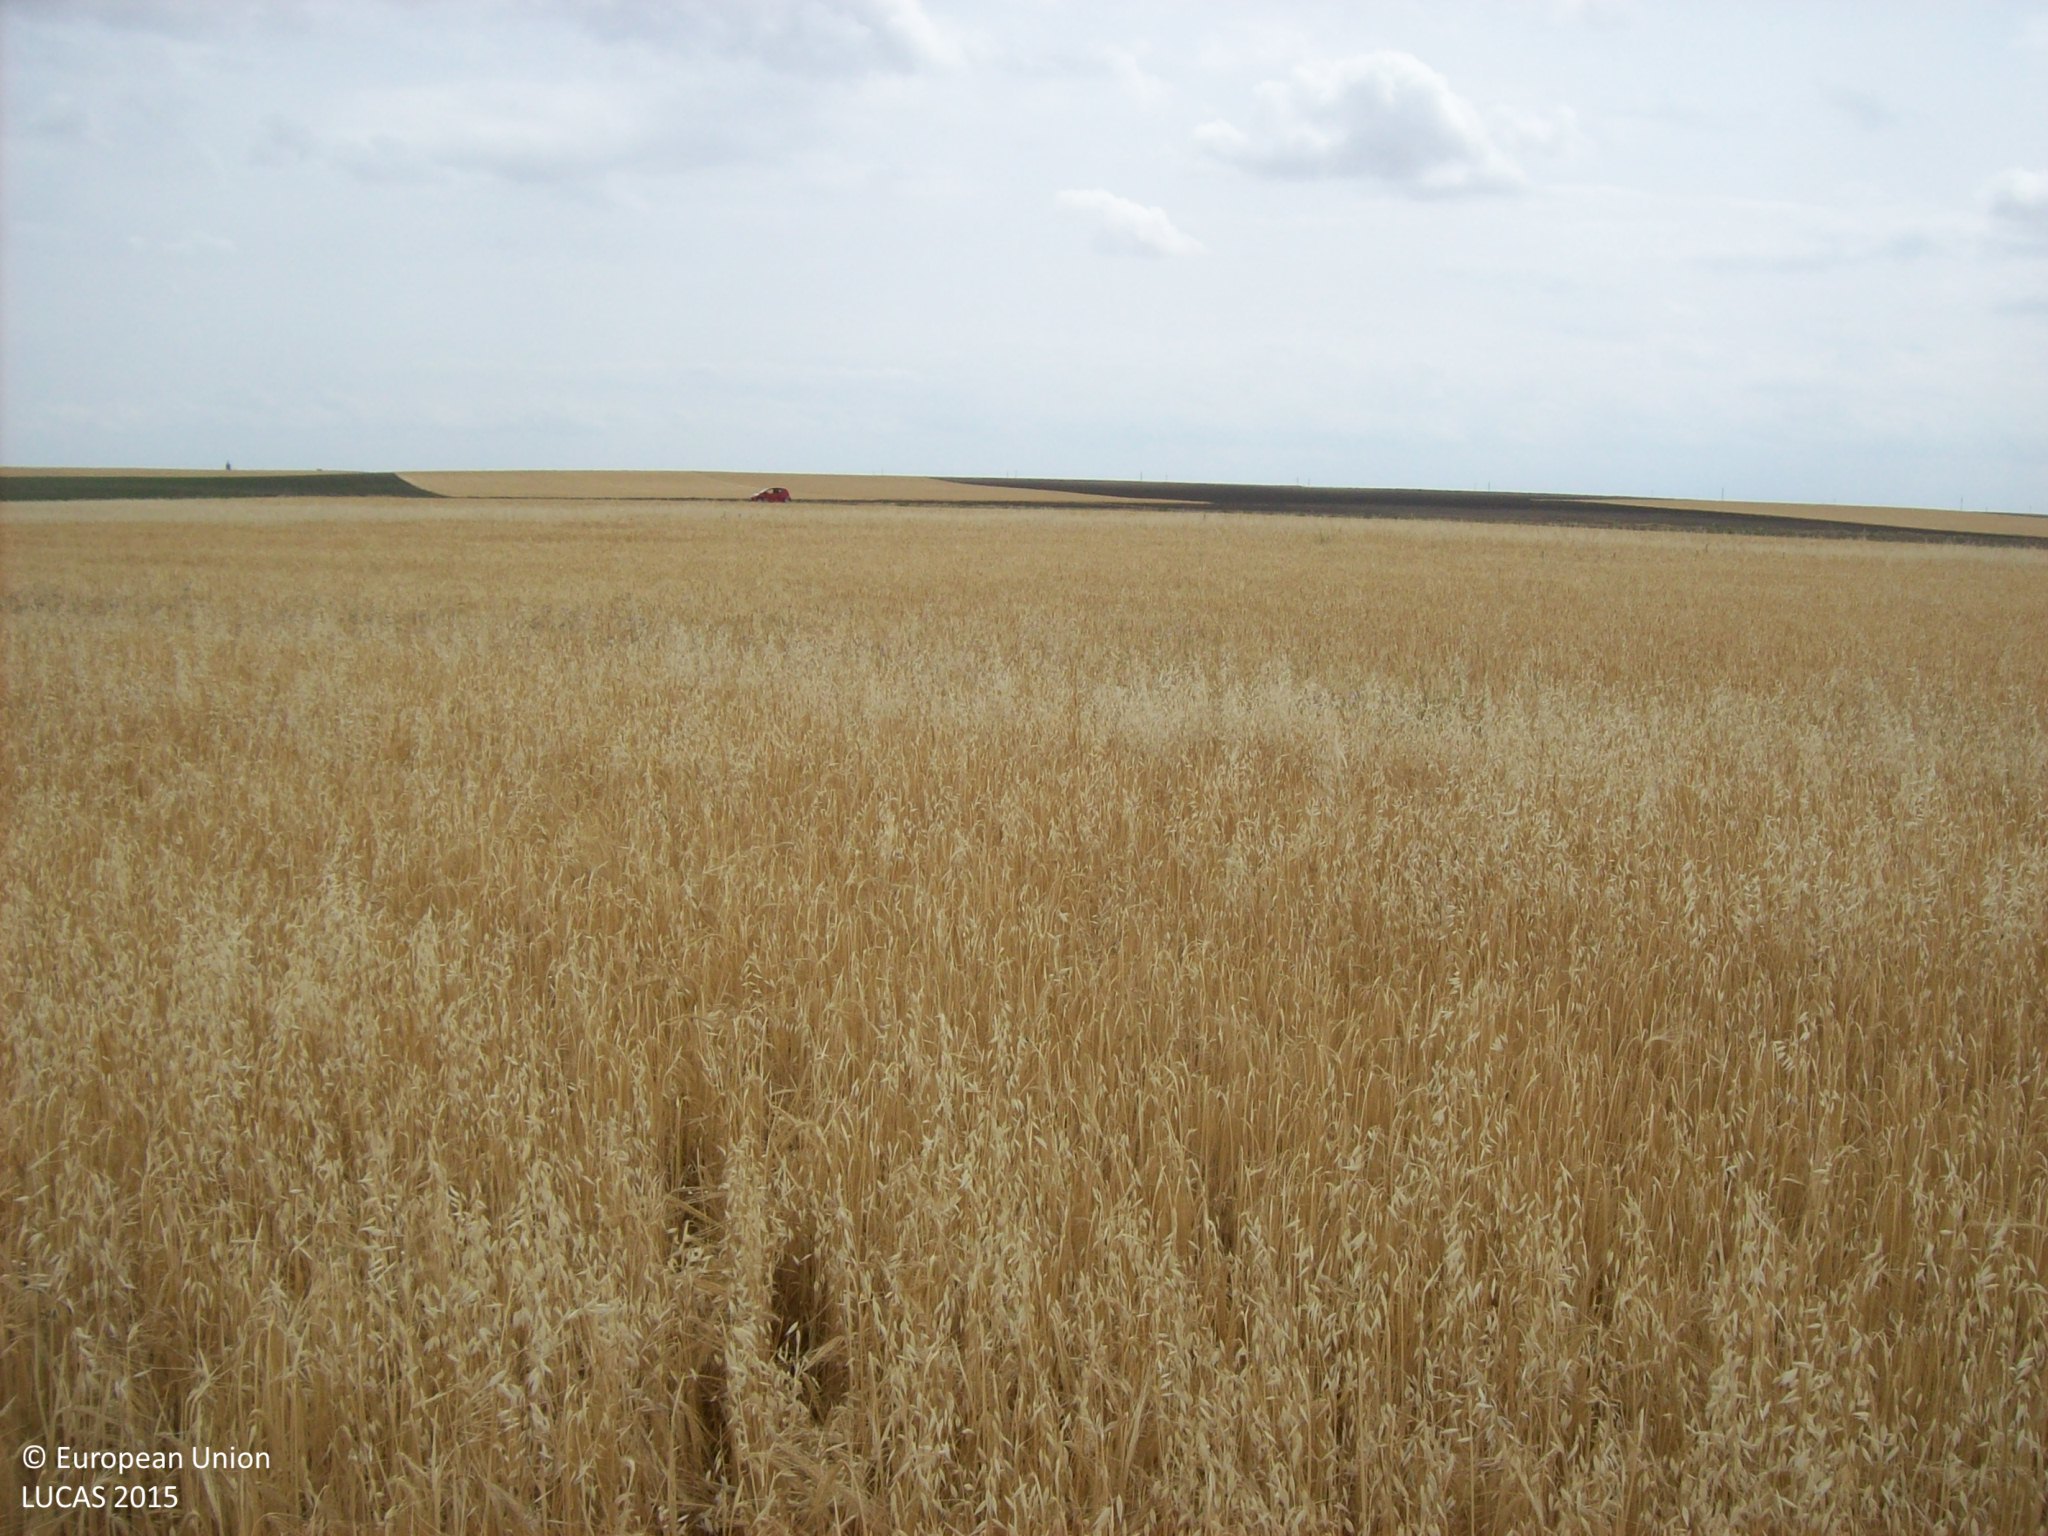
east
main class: Cropland
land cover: Barley
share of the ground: > 75 %
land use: Agriculture (excluding fallow land and kitchen gardens)
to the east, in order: Barley; Other bare soil; Grass margins; Tracks; Grass margins; Other bare soil
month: June
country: ES
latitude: 40.9646
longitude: -4.9765
